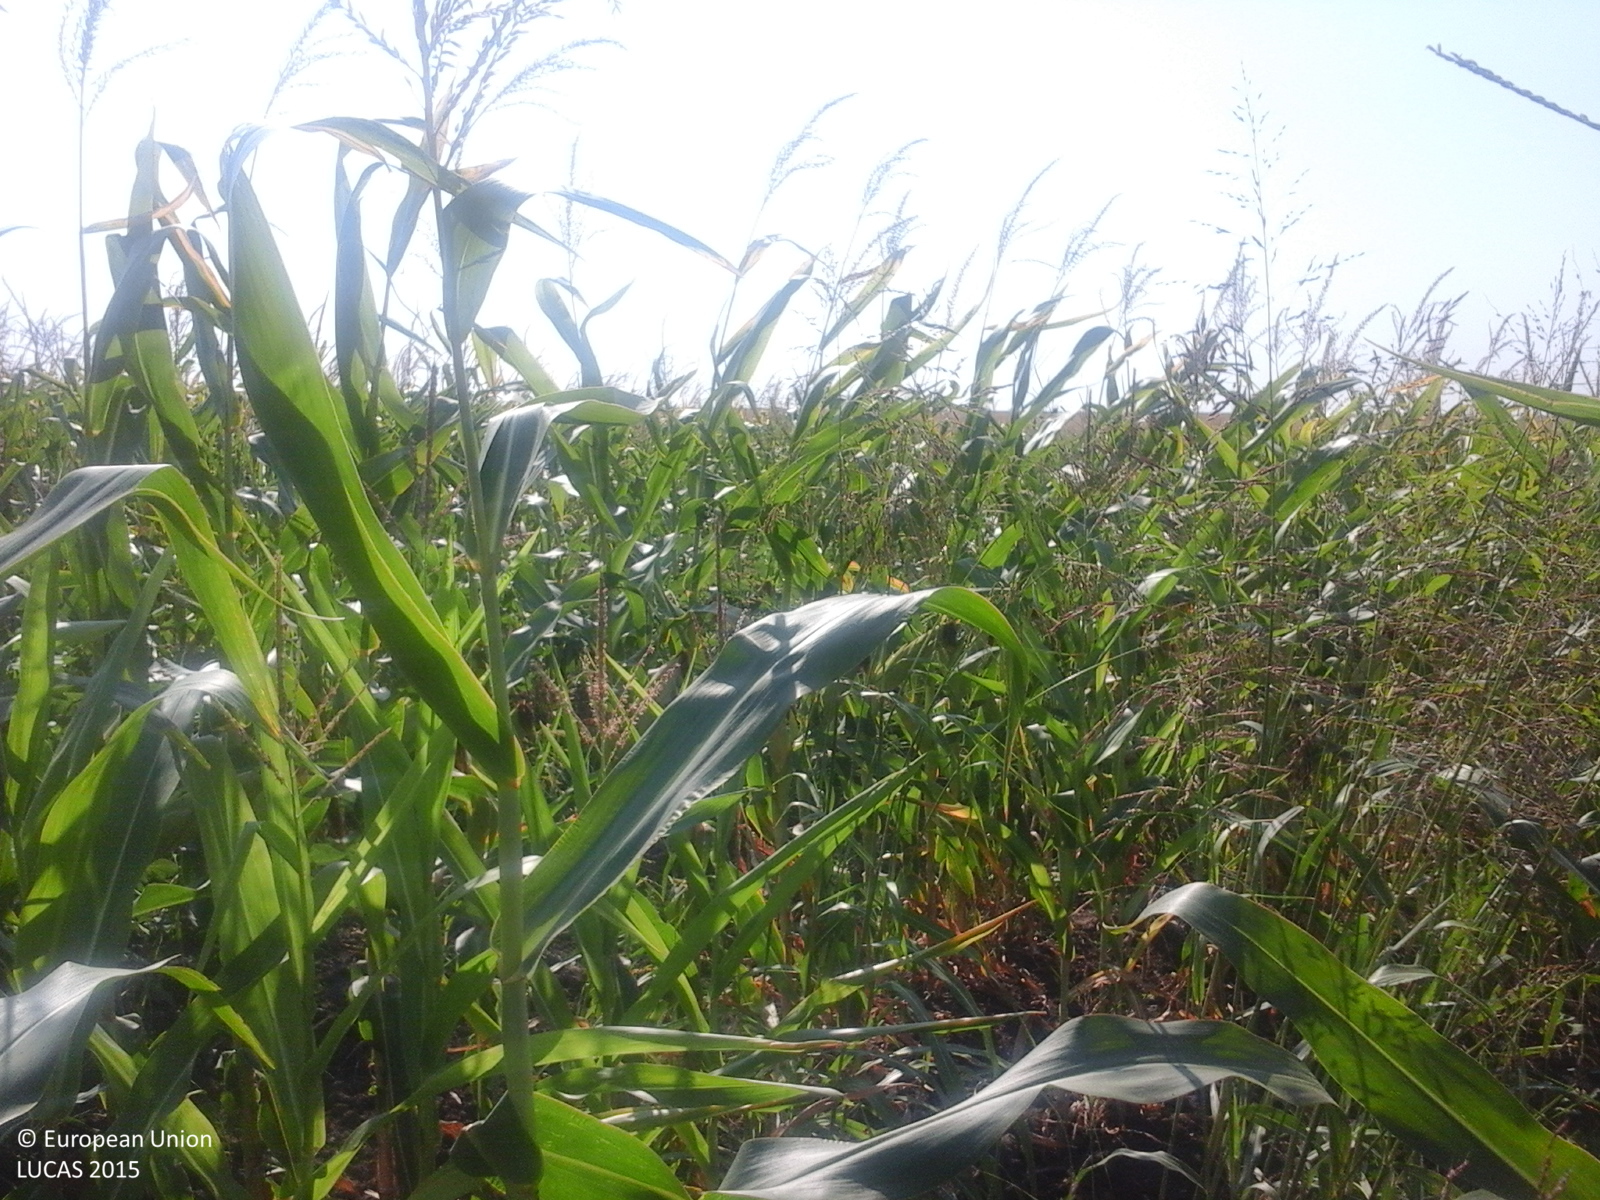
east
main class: Cropland
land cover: Maize
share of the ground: > 75 %
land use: Agriculture (excluding fallow land and kitchen gardens)
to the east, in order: Maize
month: August
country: RO
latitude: 45.7468
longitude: 27.5753
